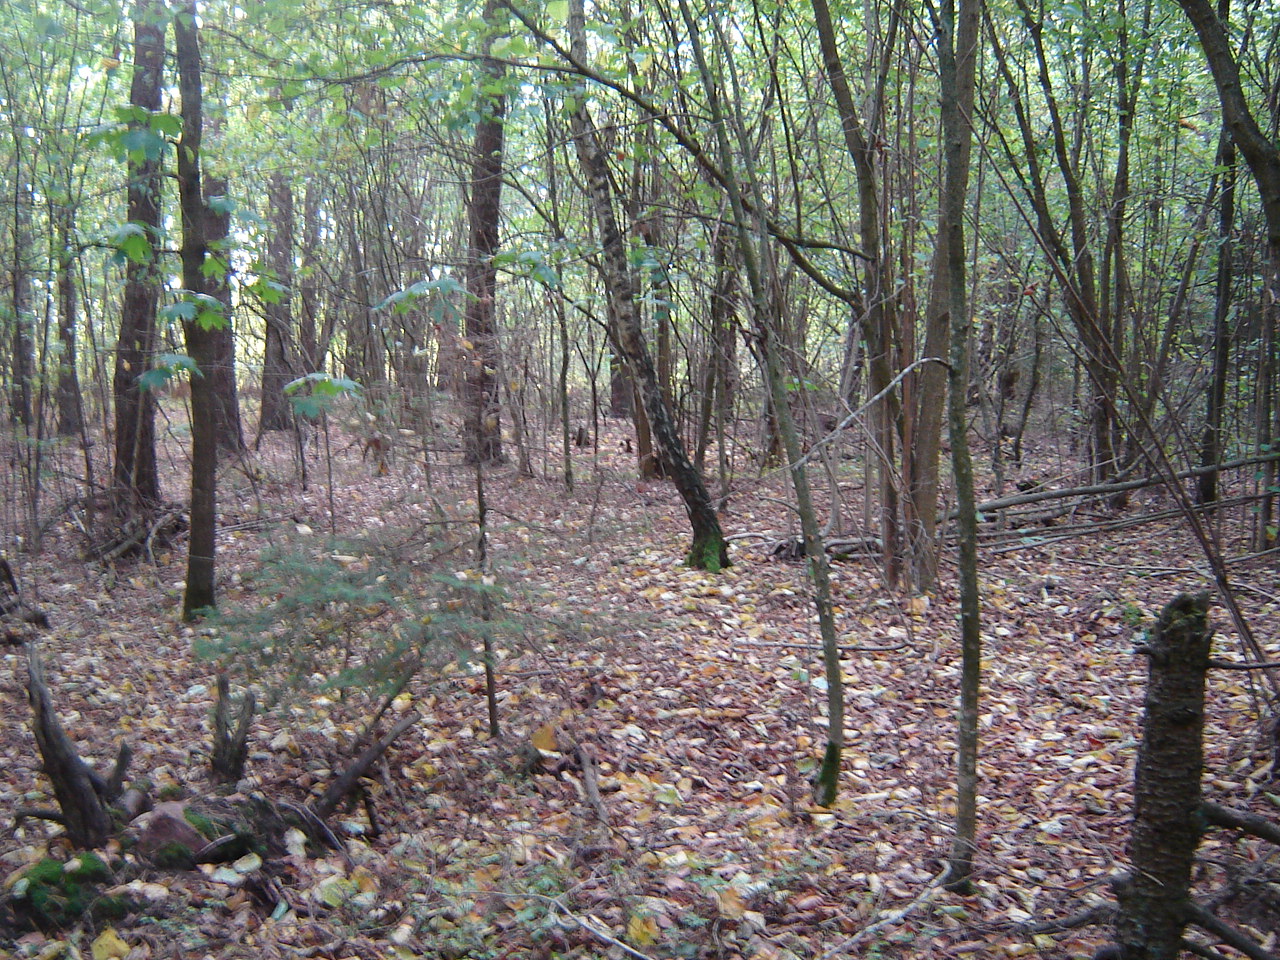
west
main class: Woodland
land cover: Pine dominated mixed woodland
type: hemiboreal forest and nemoral coniferous forest and mixed broadleaved-coniferous forest
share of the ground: > 75 %
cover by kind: broadleaved forest trees 50 %, coniferous forest trees 40 %, herbaceous plants 5 %, unconsolidated bare surface 5 %
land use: Forestry
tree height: > 5 m
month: September
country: LT
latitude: 54.1958
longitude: 25.0300
